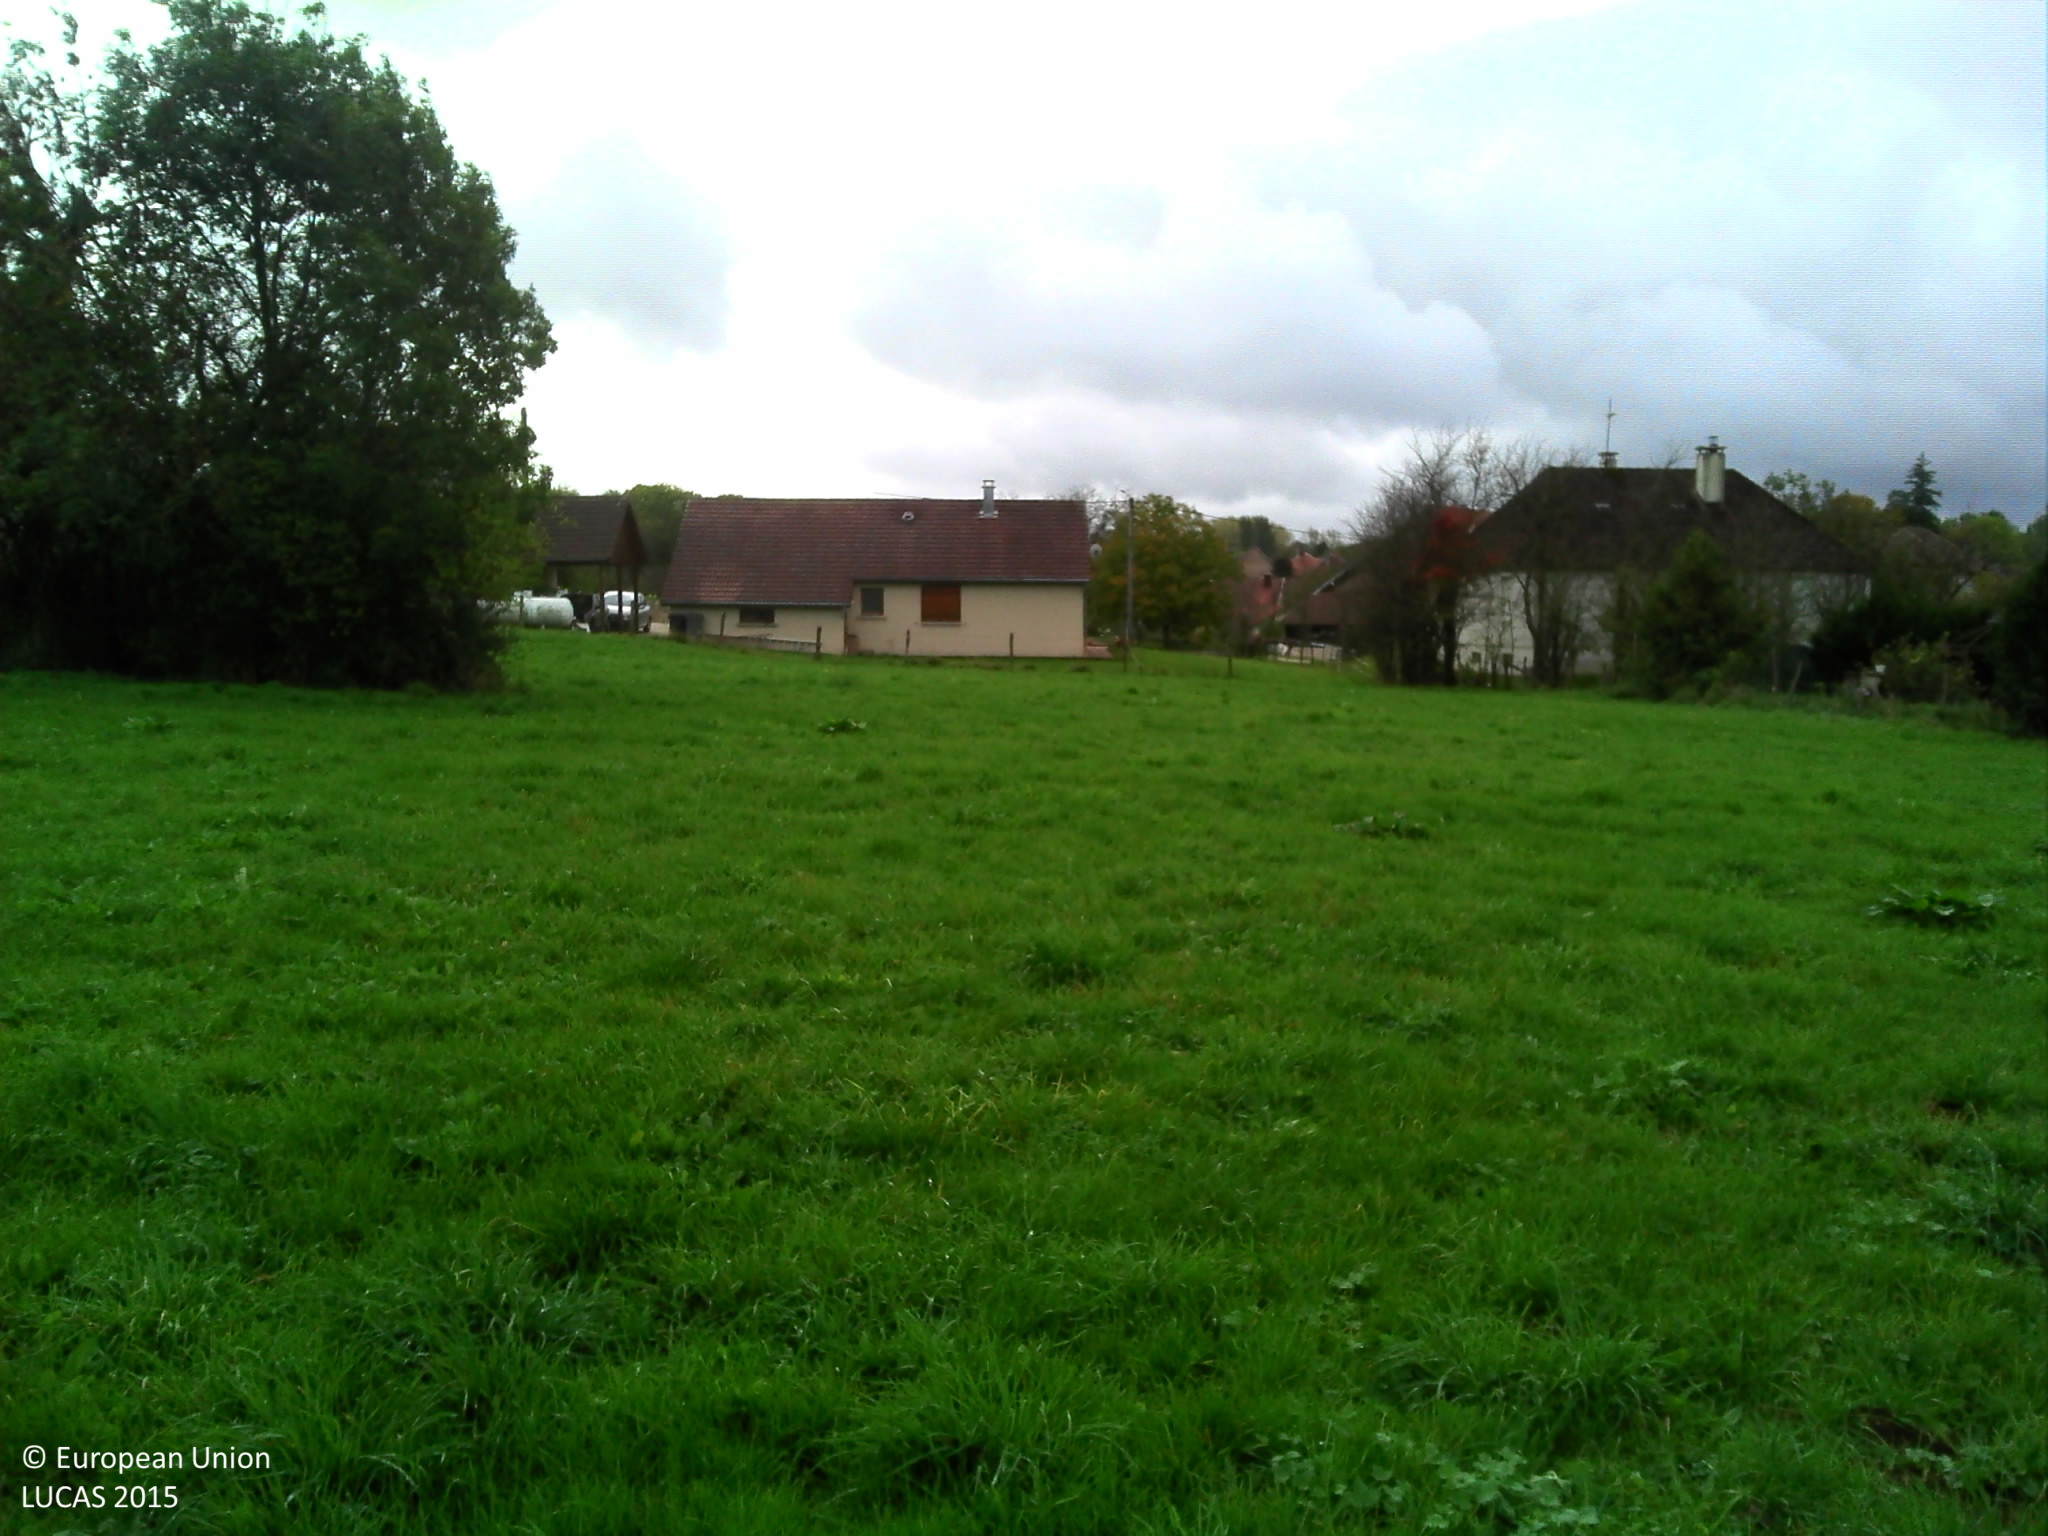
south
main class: Grassland
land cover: Grassland without tree/shrub cover
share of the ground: > 75 %
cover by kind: herbaceous plants 100 %
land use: Agriculture (excluding fallow land and kitchen gardens)
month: October
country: FR
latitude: 47.0541
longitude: 6.0659
